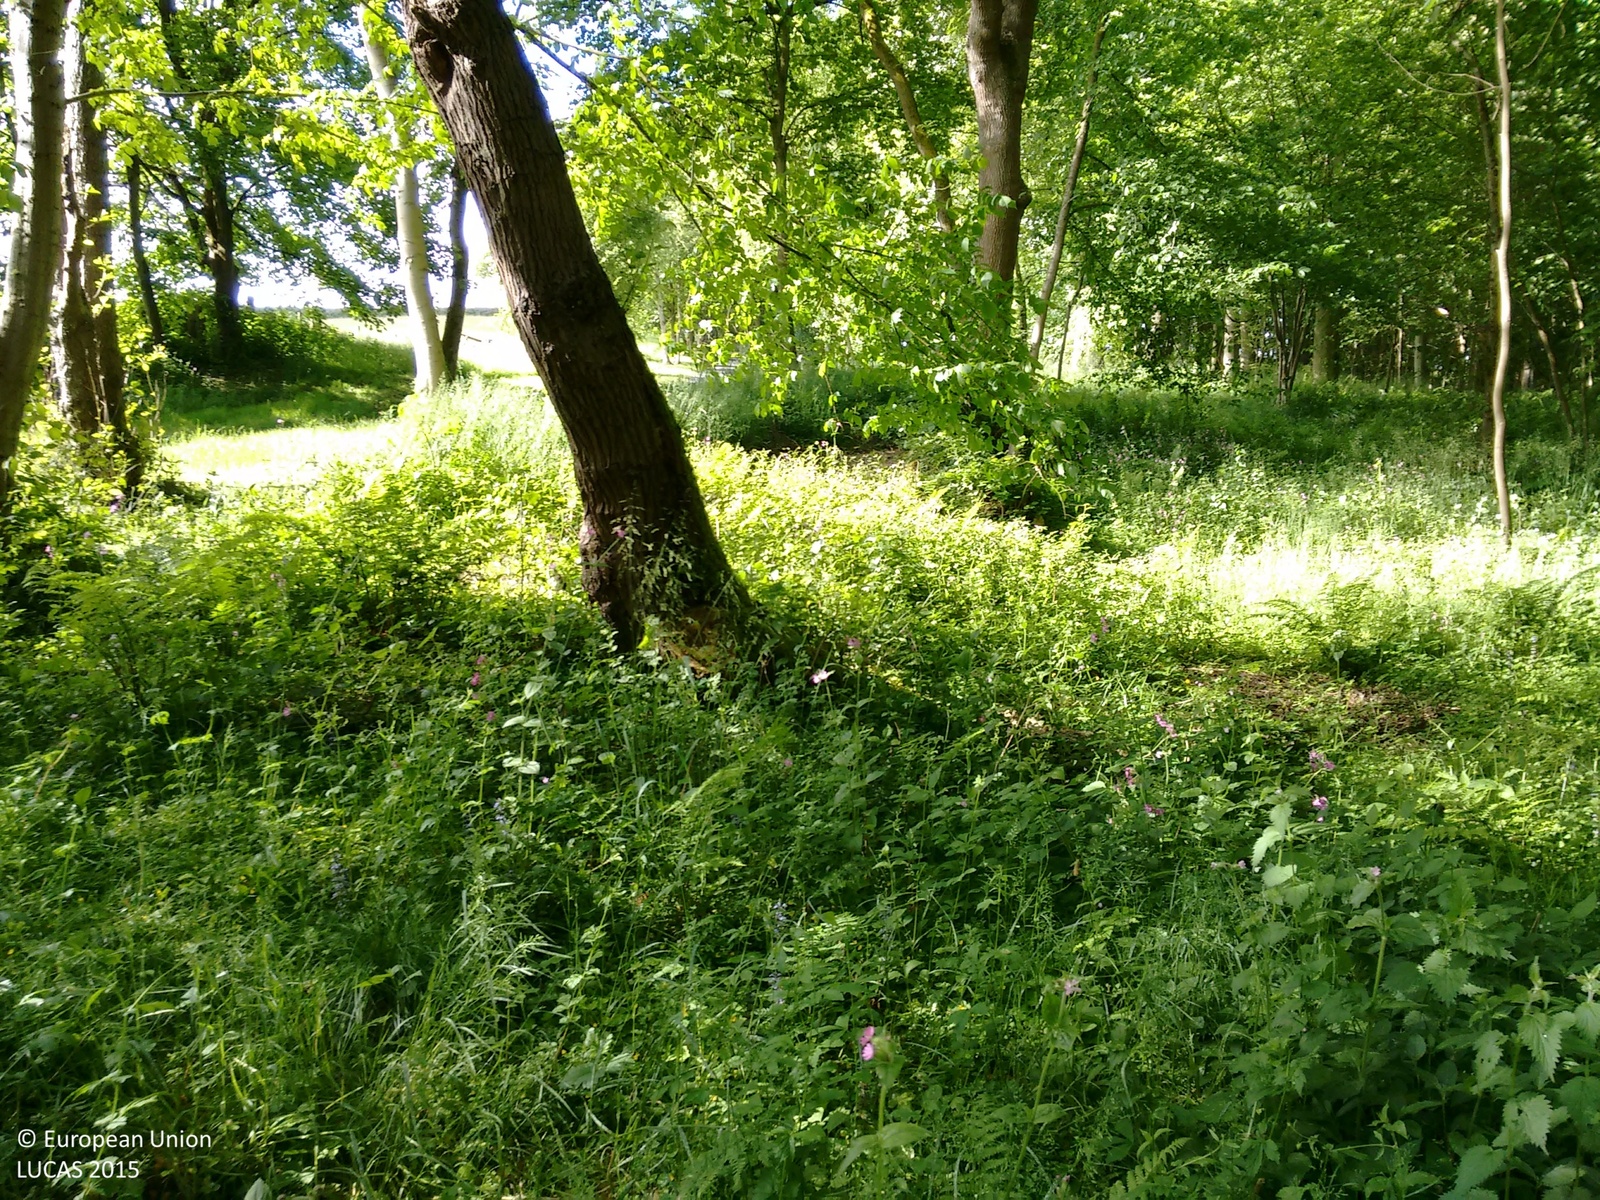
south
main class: Woodland
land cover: Broadleaved woodland
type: mesophytic deciduous forest
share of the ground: > 75 %
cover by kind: broadleaved forest trees 80 %, coniferous forest trees 20 %
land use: Sport
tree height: > 5 m
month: June
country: GB
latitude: 54.1471
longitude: -1.0507
